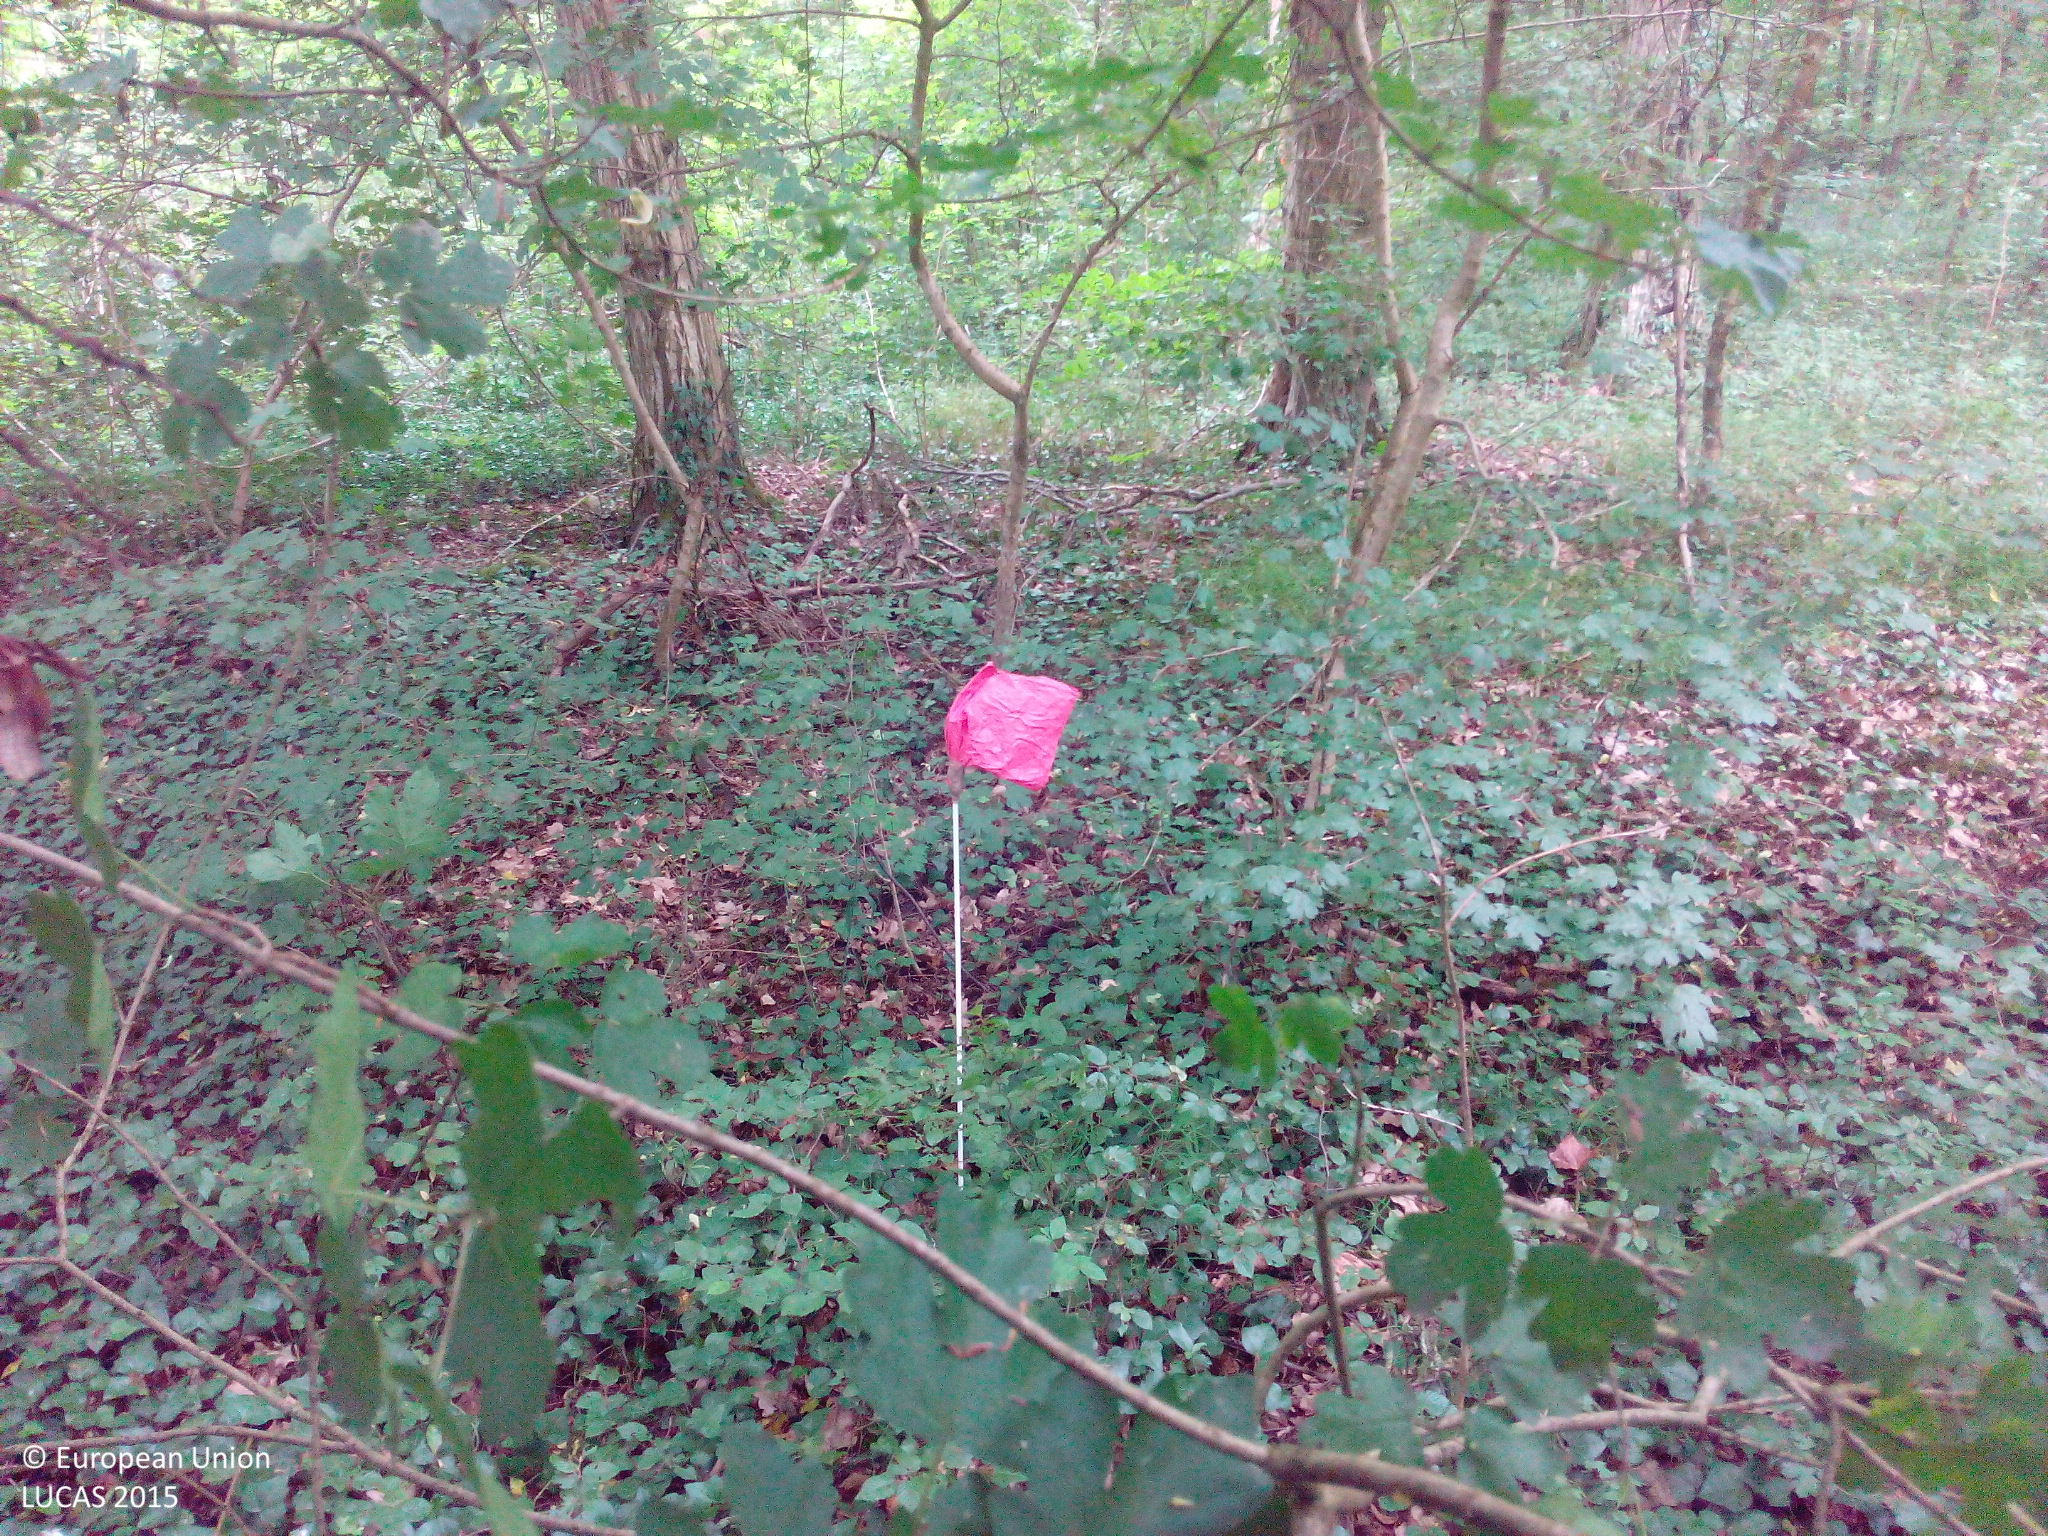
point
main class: Woodland
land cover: Broadleaved woodland
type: mesophytic deciduous forest
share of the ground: > 75 %
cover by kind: broadleaved forest trees 90 %, shrubs 5 %, herbaceous plants 5 %
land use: Forestry
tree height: > 5 m
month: June
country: DE
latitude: 49.2461
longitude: 9.1899
